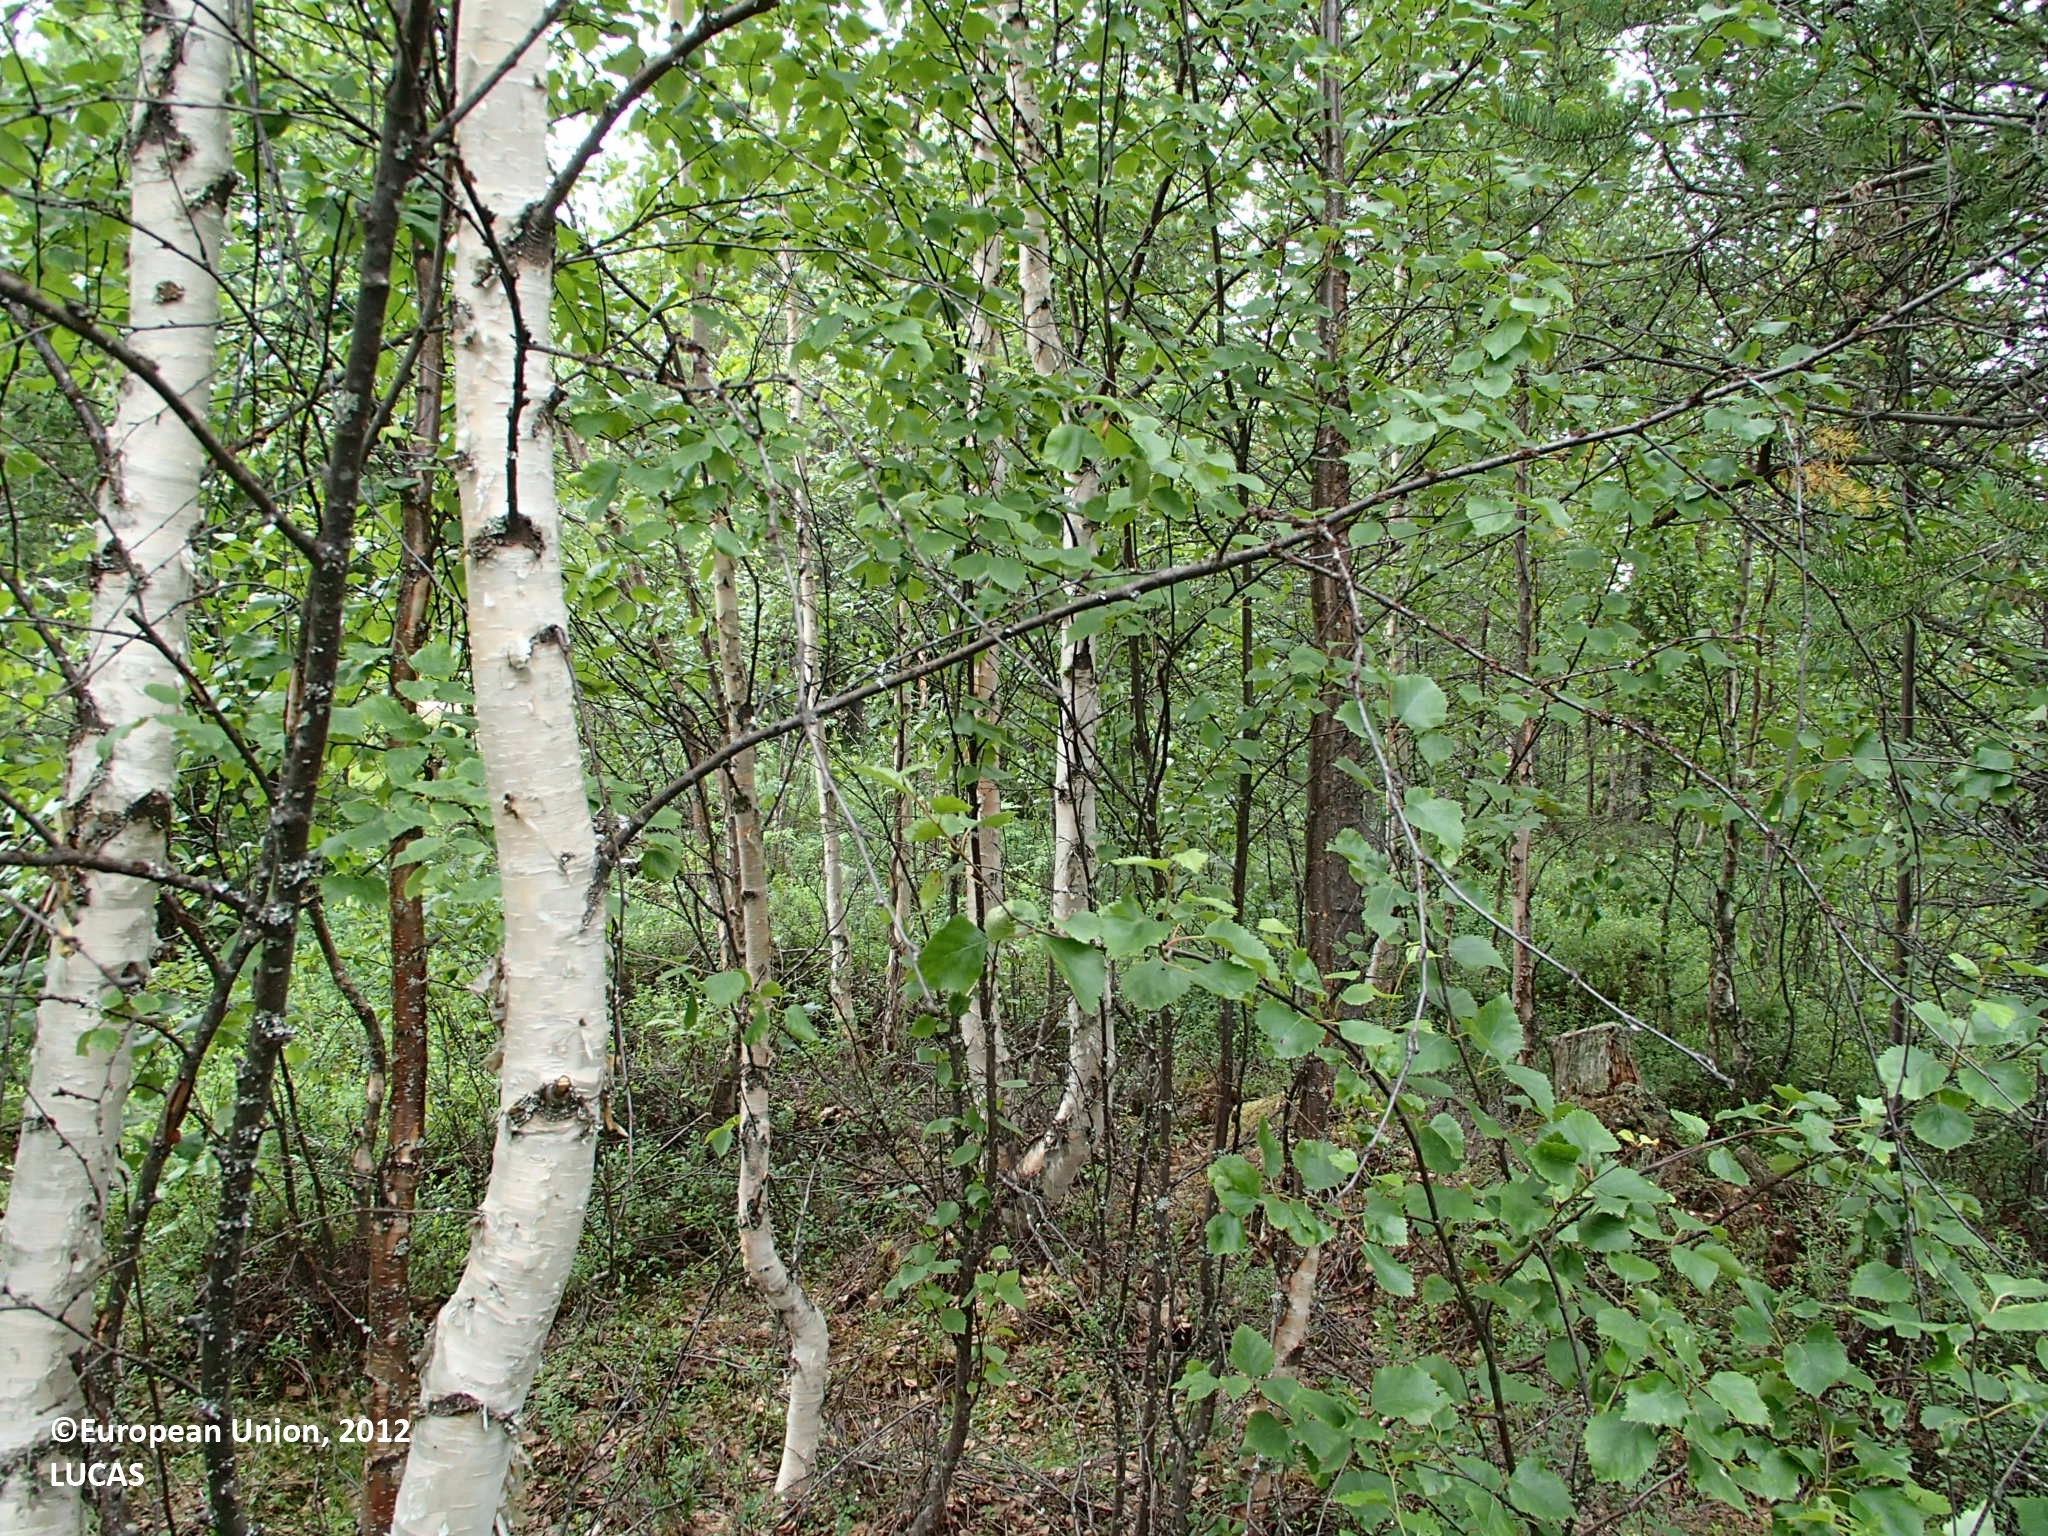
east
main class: Woodland
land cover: Other mixed woodland
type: boreal forest
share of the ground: > 75 %
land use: Forestry
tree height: > 5 m
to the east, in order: Other mixed woodland; Ditches and canals; Paved roads, cycling and walking lanes; Ditches and canals; Other mixed woodland; Pine dominated coniferous woodland
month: July
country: FI
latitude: 66.9873
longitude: 25.4366
